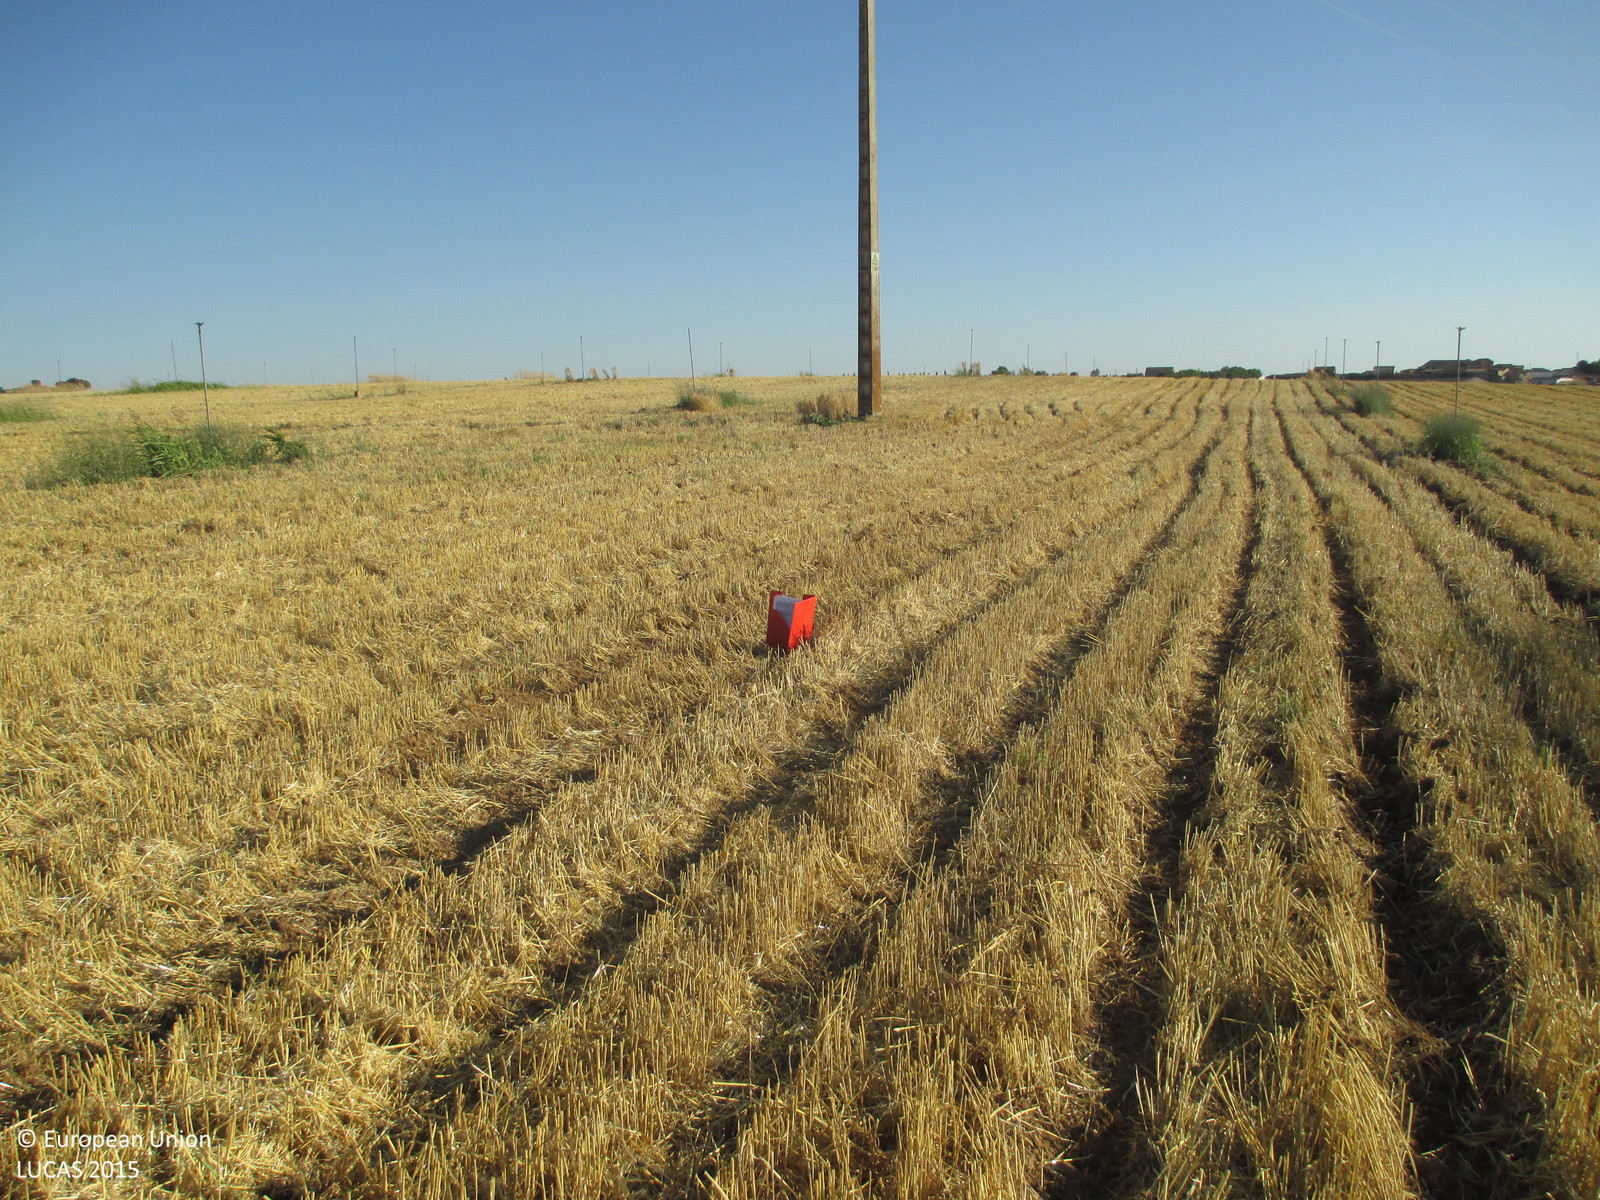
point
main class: Cropland
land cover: Sunflower
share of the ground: < 10 %
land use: Agriculture (excluding fallow land and kitchen gardens)
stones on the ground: < 10 %
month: June
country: ES
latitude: 42.0291
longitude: -0.3725
